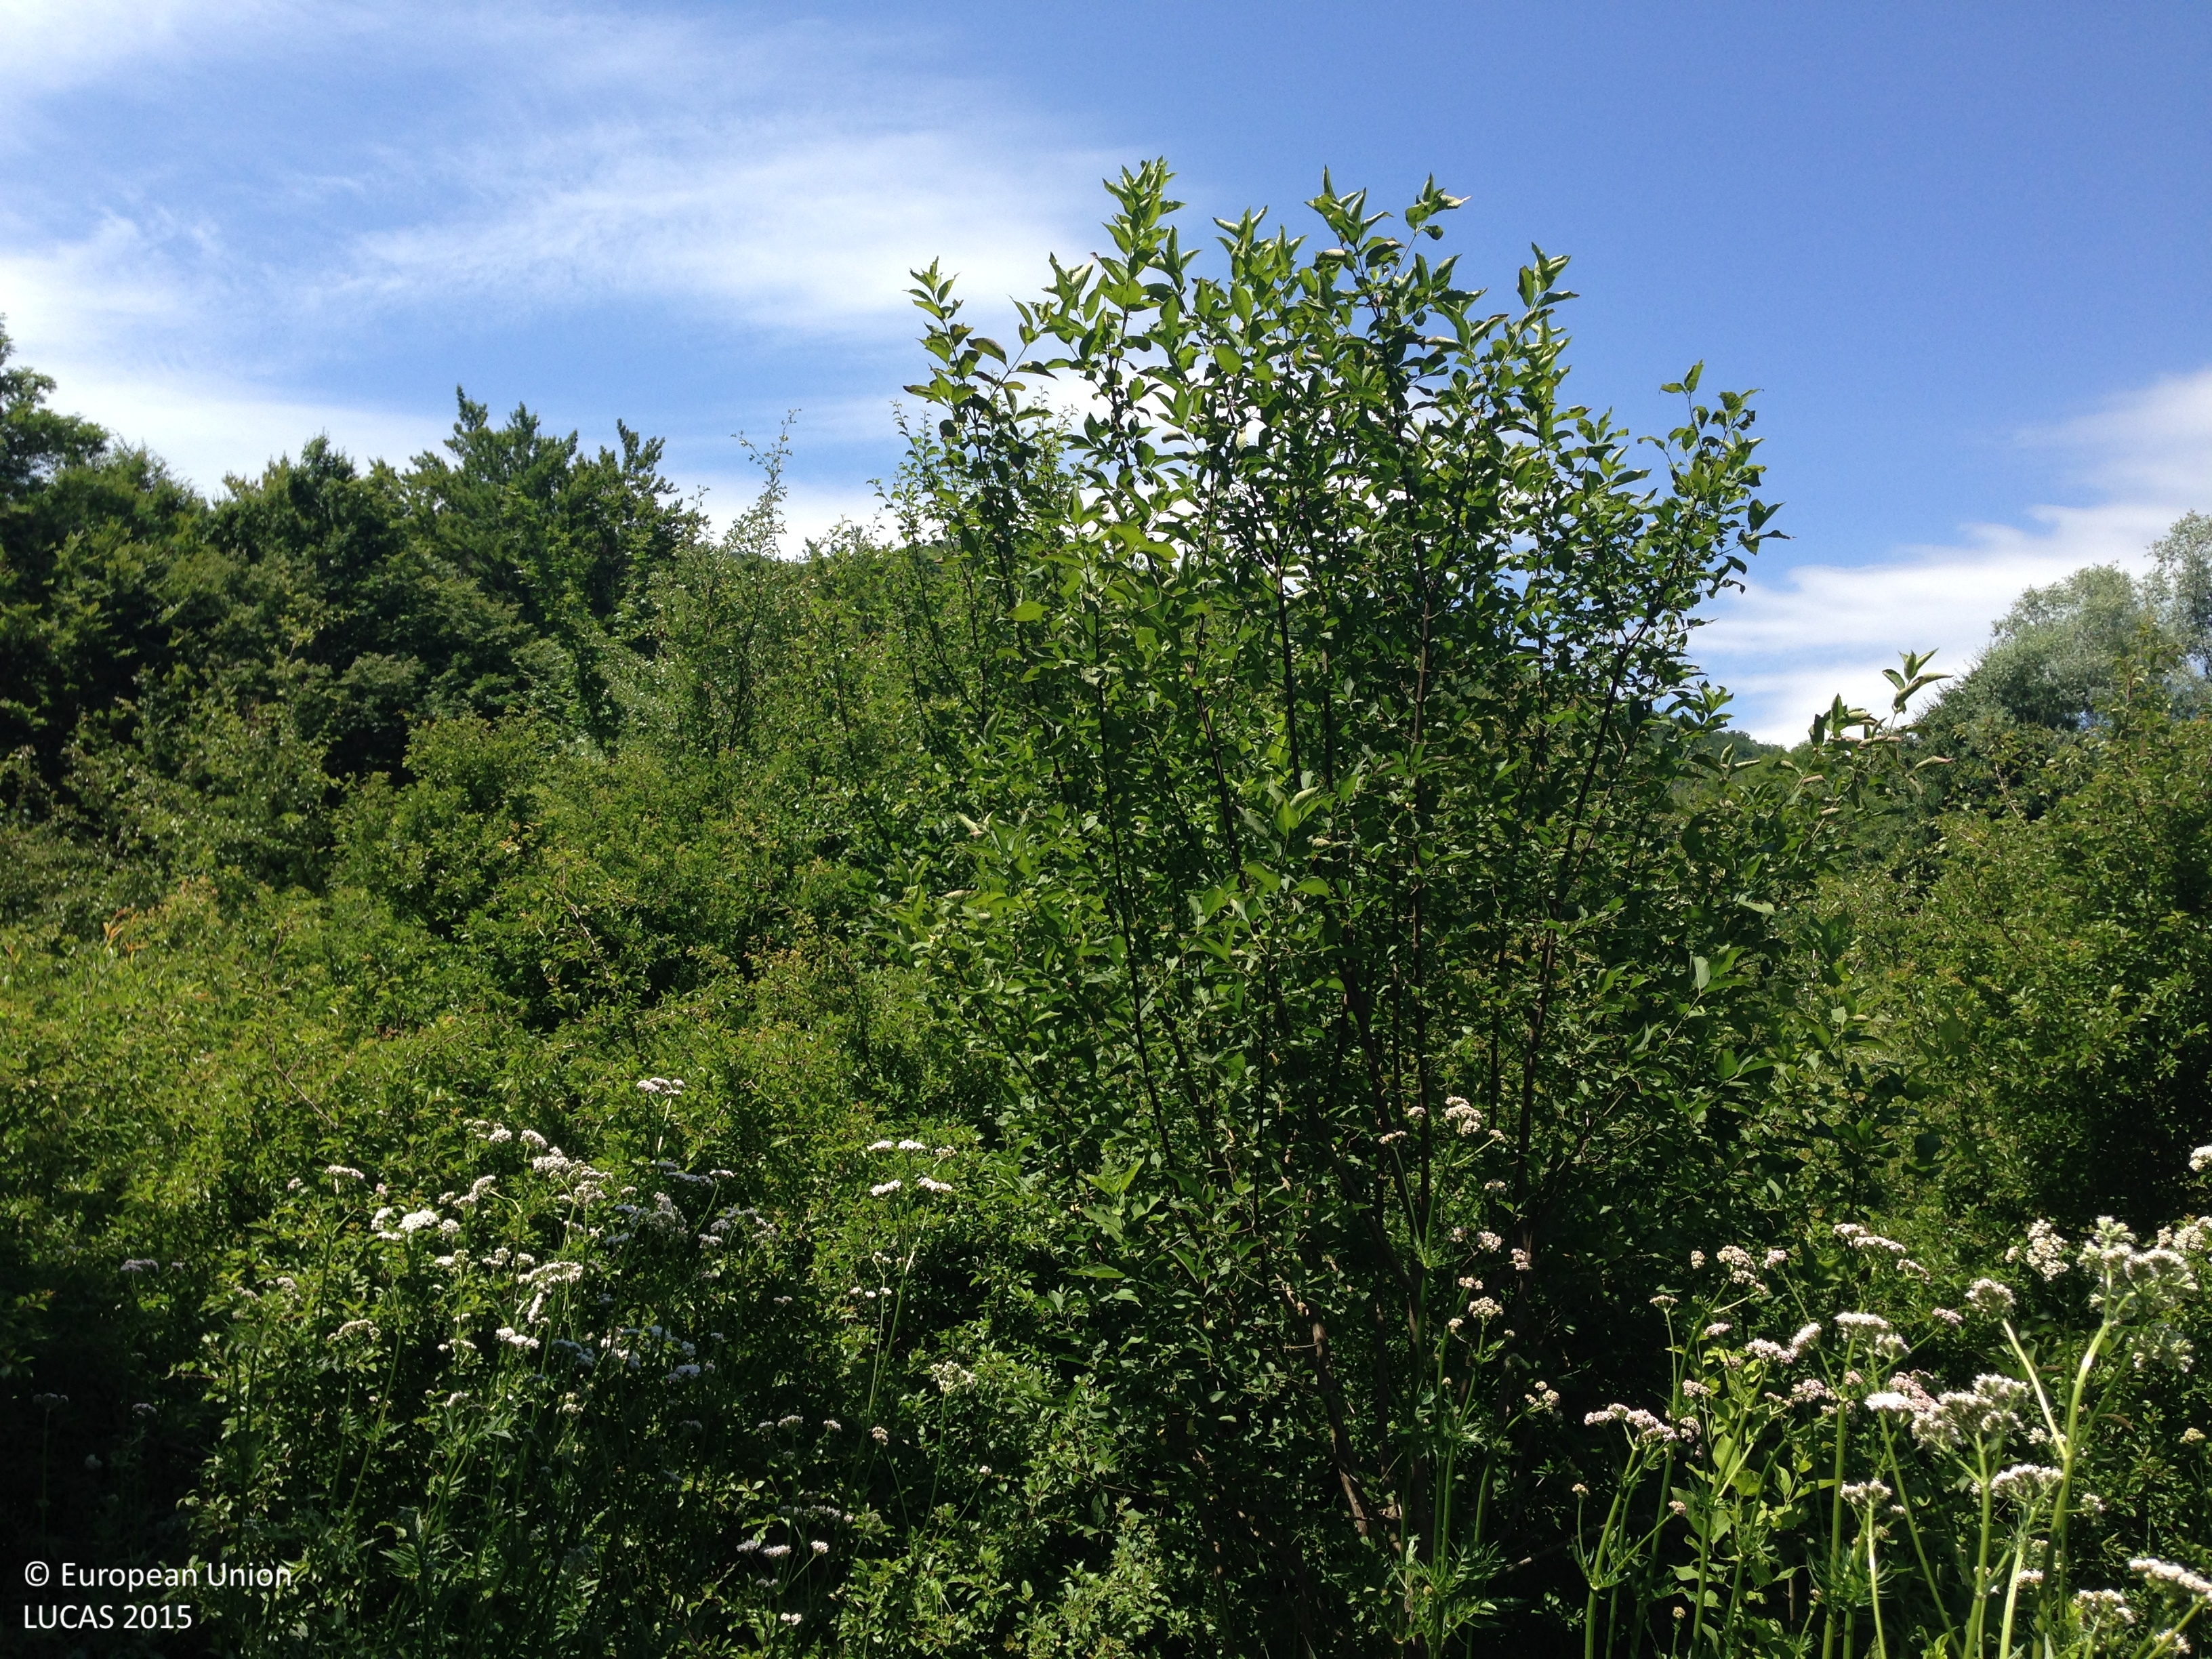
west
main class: Woodland
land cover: Broadleaved woodland
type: thermophilous deciduous forest
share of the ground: 25 - 50 %
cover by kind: herbaceous plants 40 %, broadleaved forest trees 30 %, shrubs 30 %
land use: Forestry
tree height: > 5 m
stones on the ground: < 10 %
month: July
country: HR
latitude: 44.5986
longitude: 15.2217
